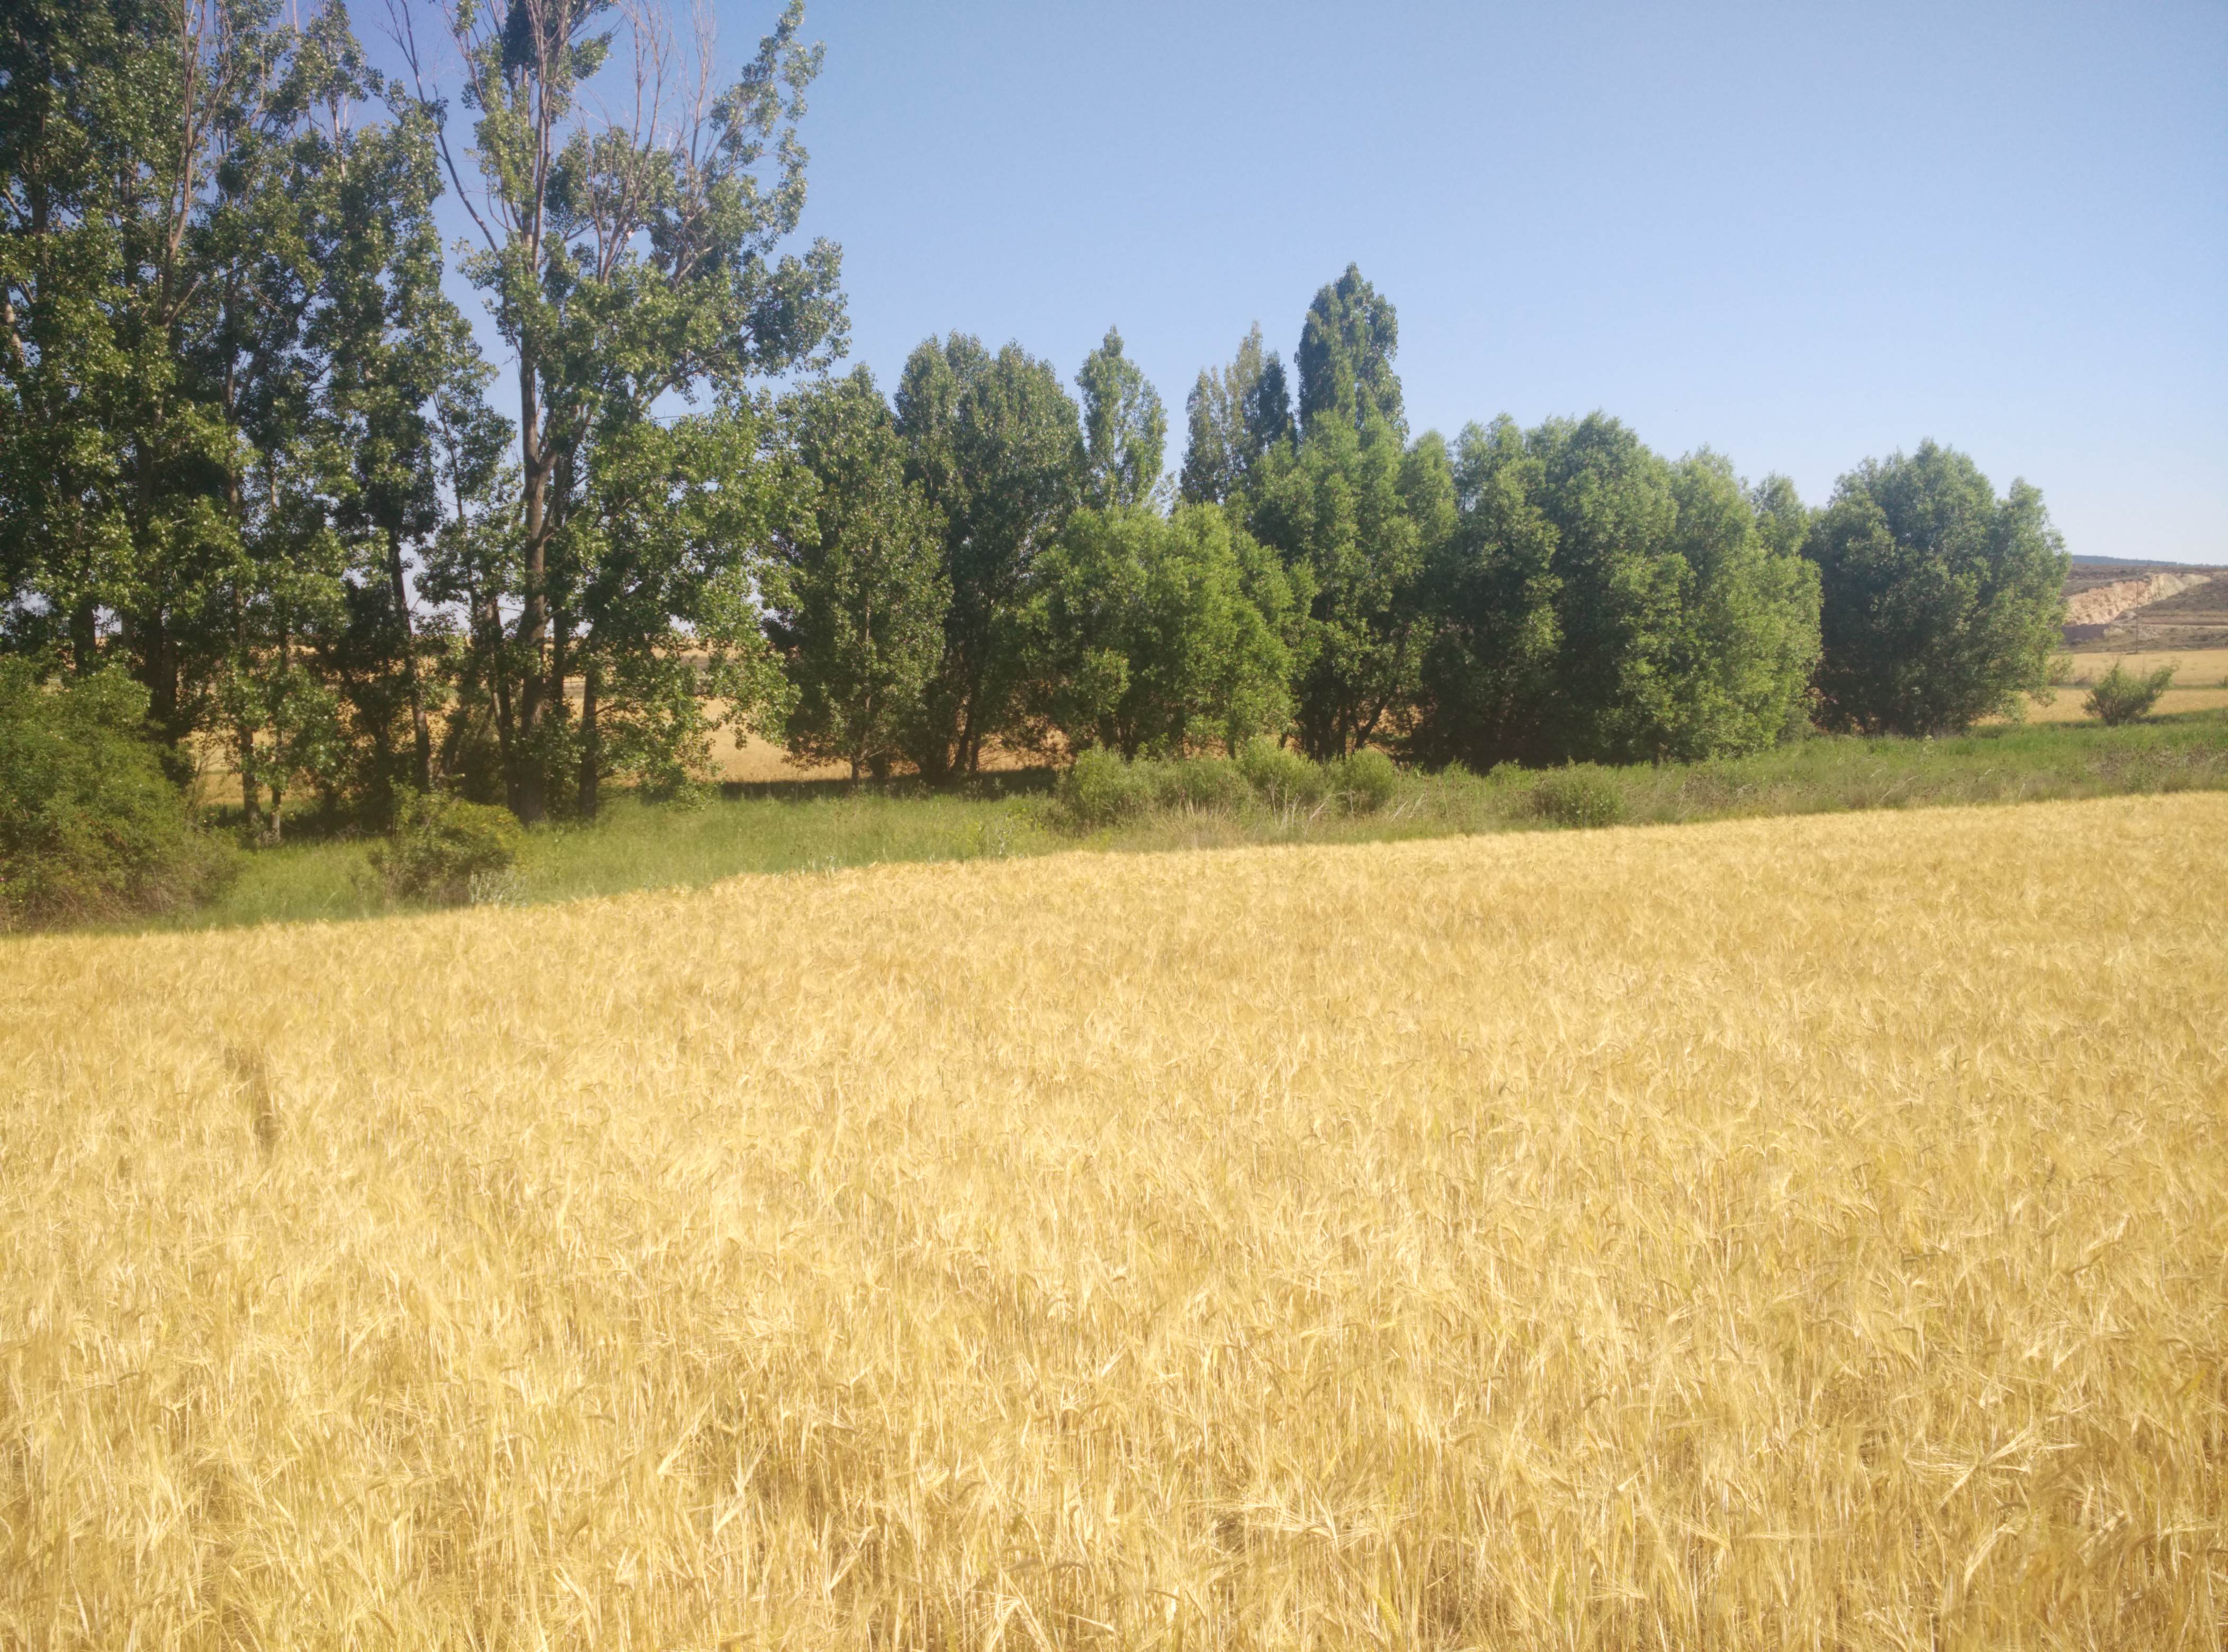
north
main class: Cropland
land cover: Barley
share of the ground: > 75 %
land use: Agriculture (excluding fallow land and kitchen gardens)
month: June
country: ES
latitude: 40.8161
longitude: -1.7697
